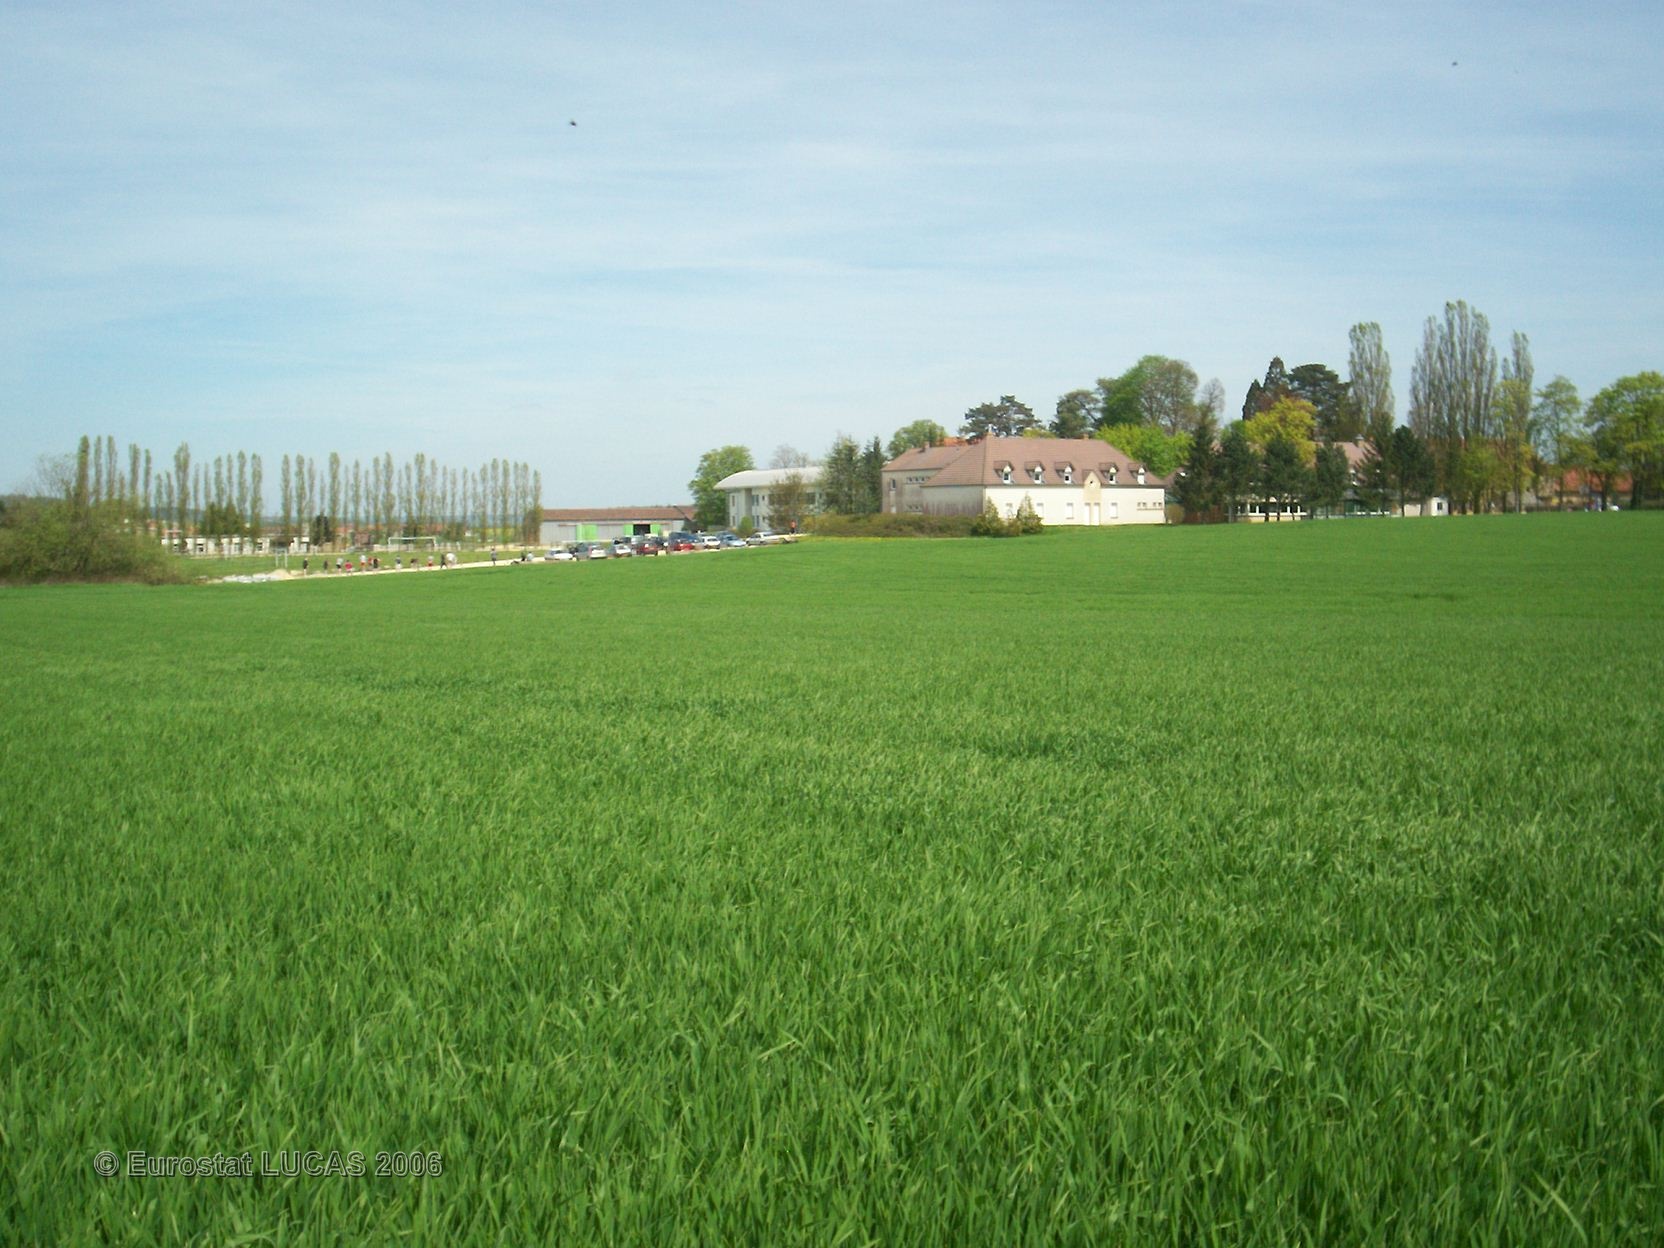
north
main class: Cropland
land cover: Barley
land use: Agriculture (excluding fallow land and kitchen gardens)
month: May
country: FR
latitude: 47.8574
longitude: 4.6121
